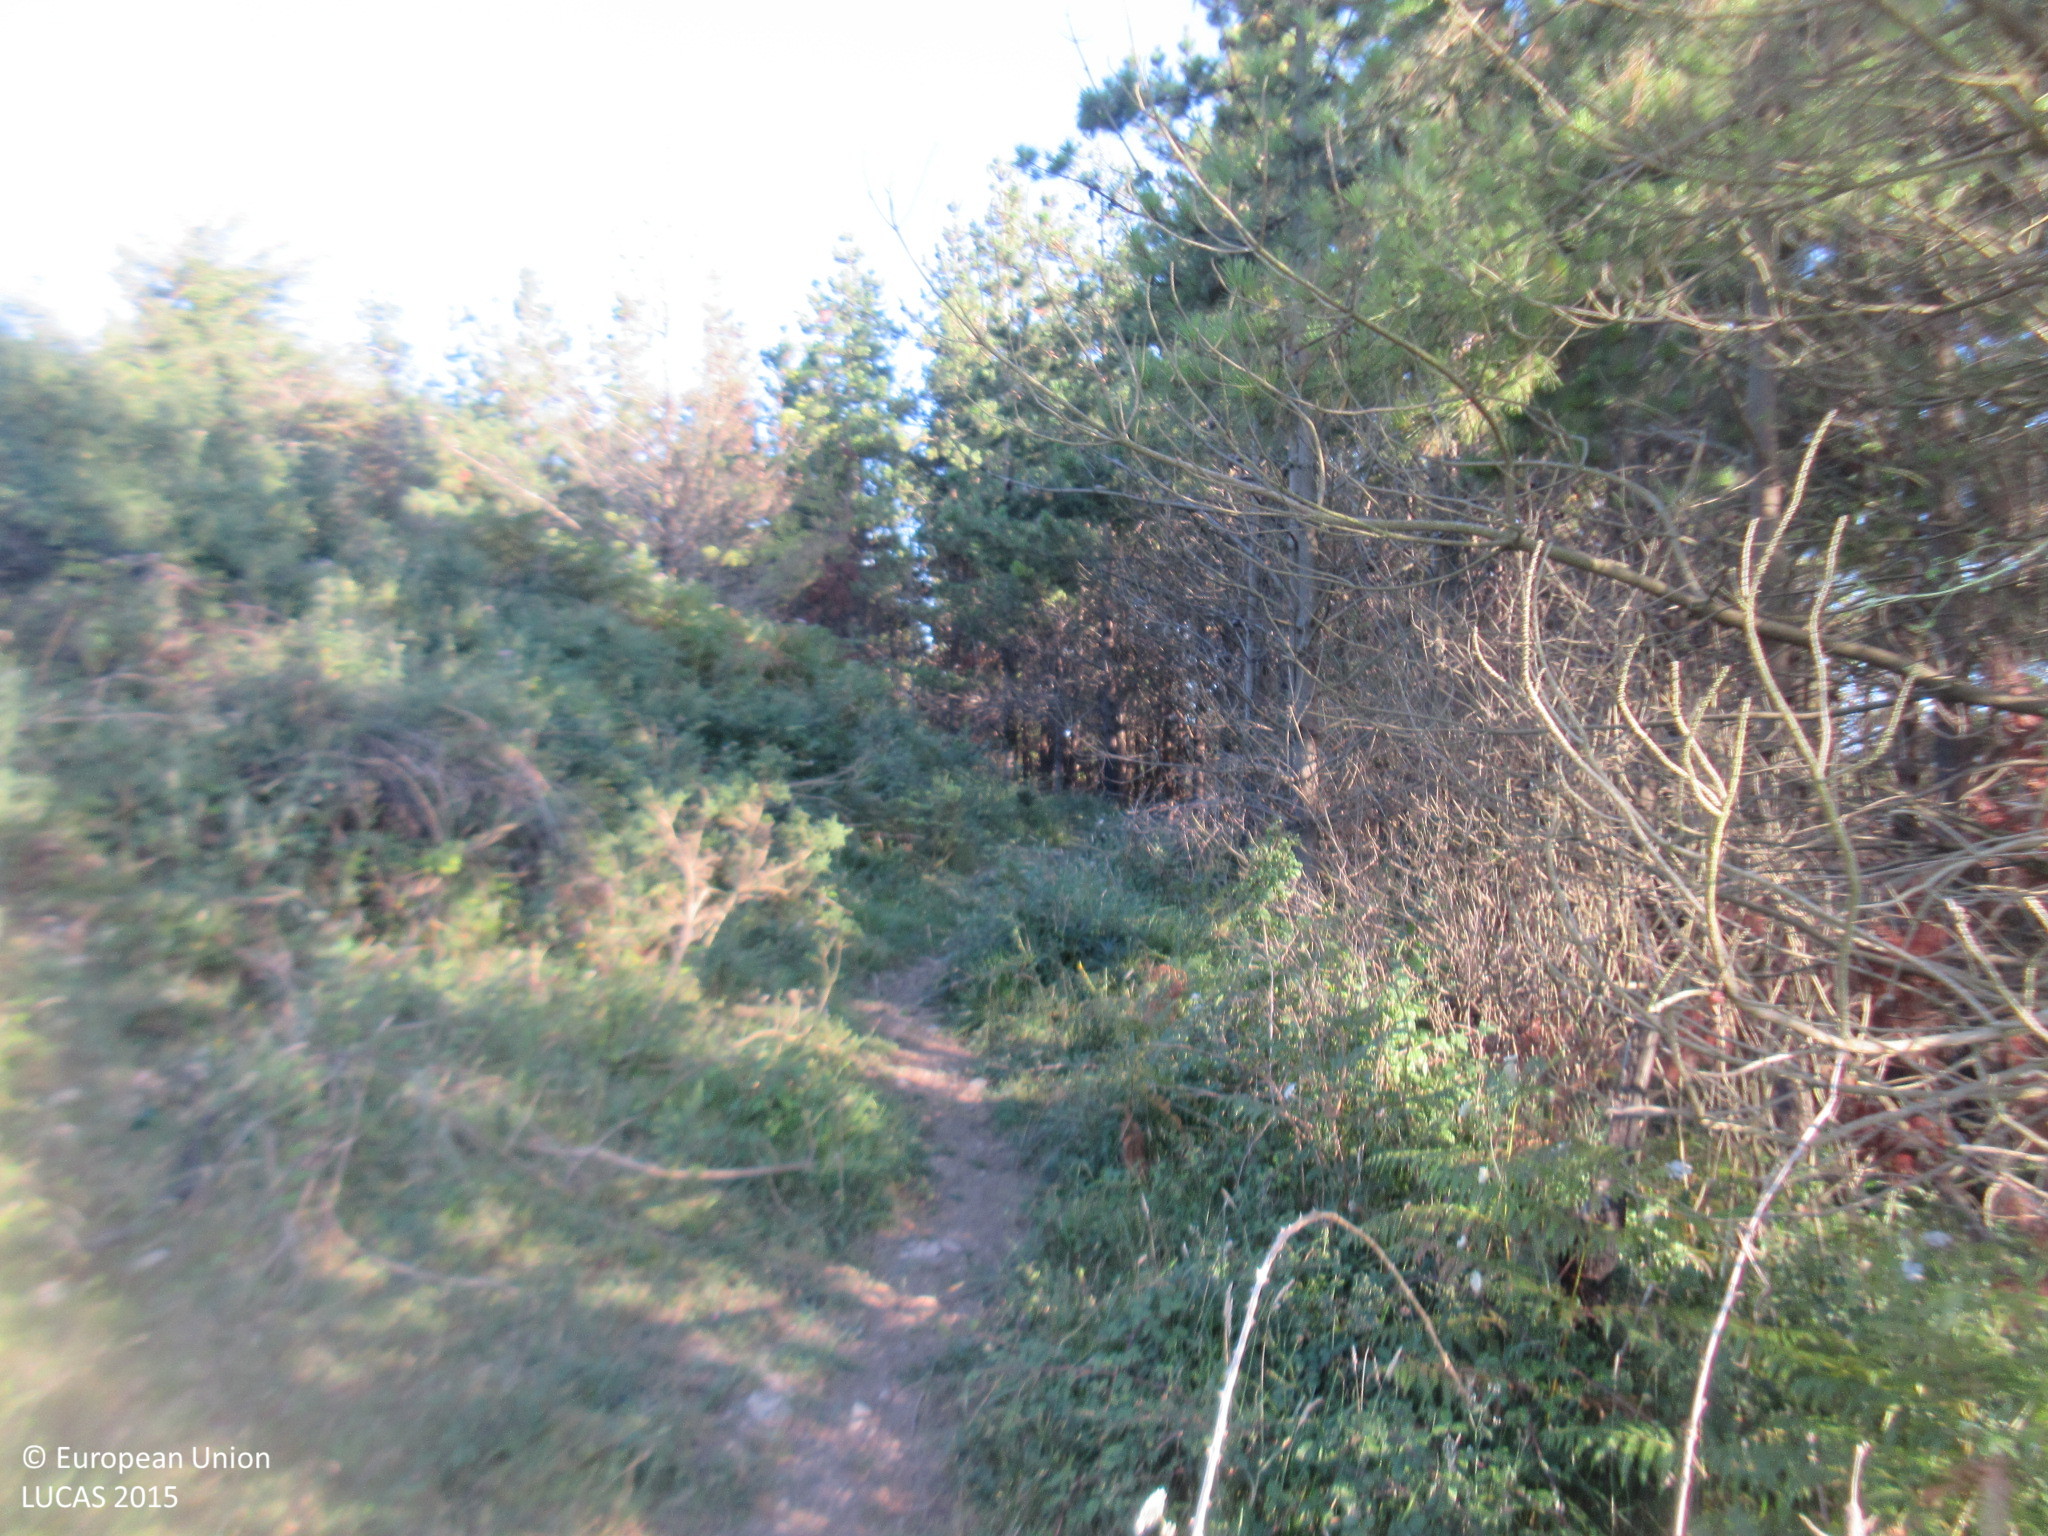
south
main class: Woodland
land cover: Pine dominated coniferous woodland
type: hemiboreal forest and nemoral coniferous forest and mixed broadleaved-coniferous forest
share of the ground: > 75 %
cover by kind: coniferous forest trees 95 %, shrubs 5 %
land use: Forestry
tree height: > 5 m
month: July
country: ES
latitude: 43.2237
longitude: -3.9238
